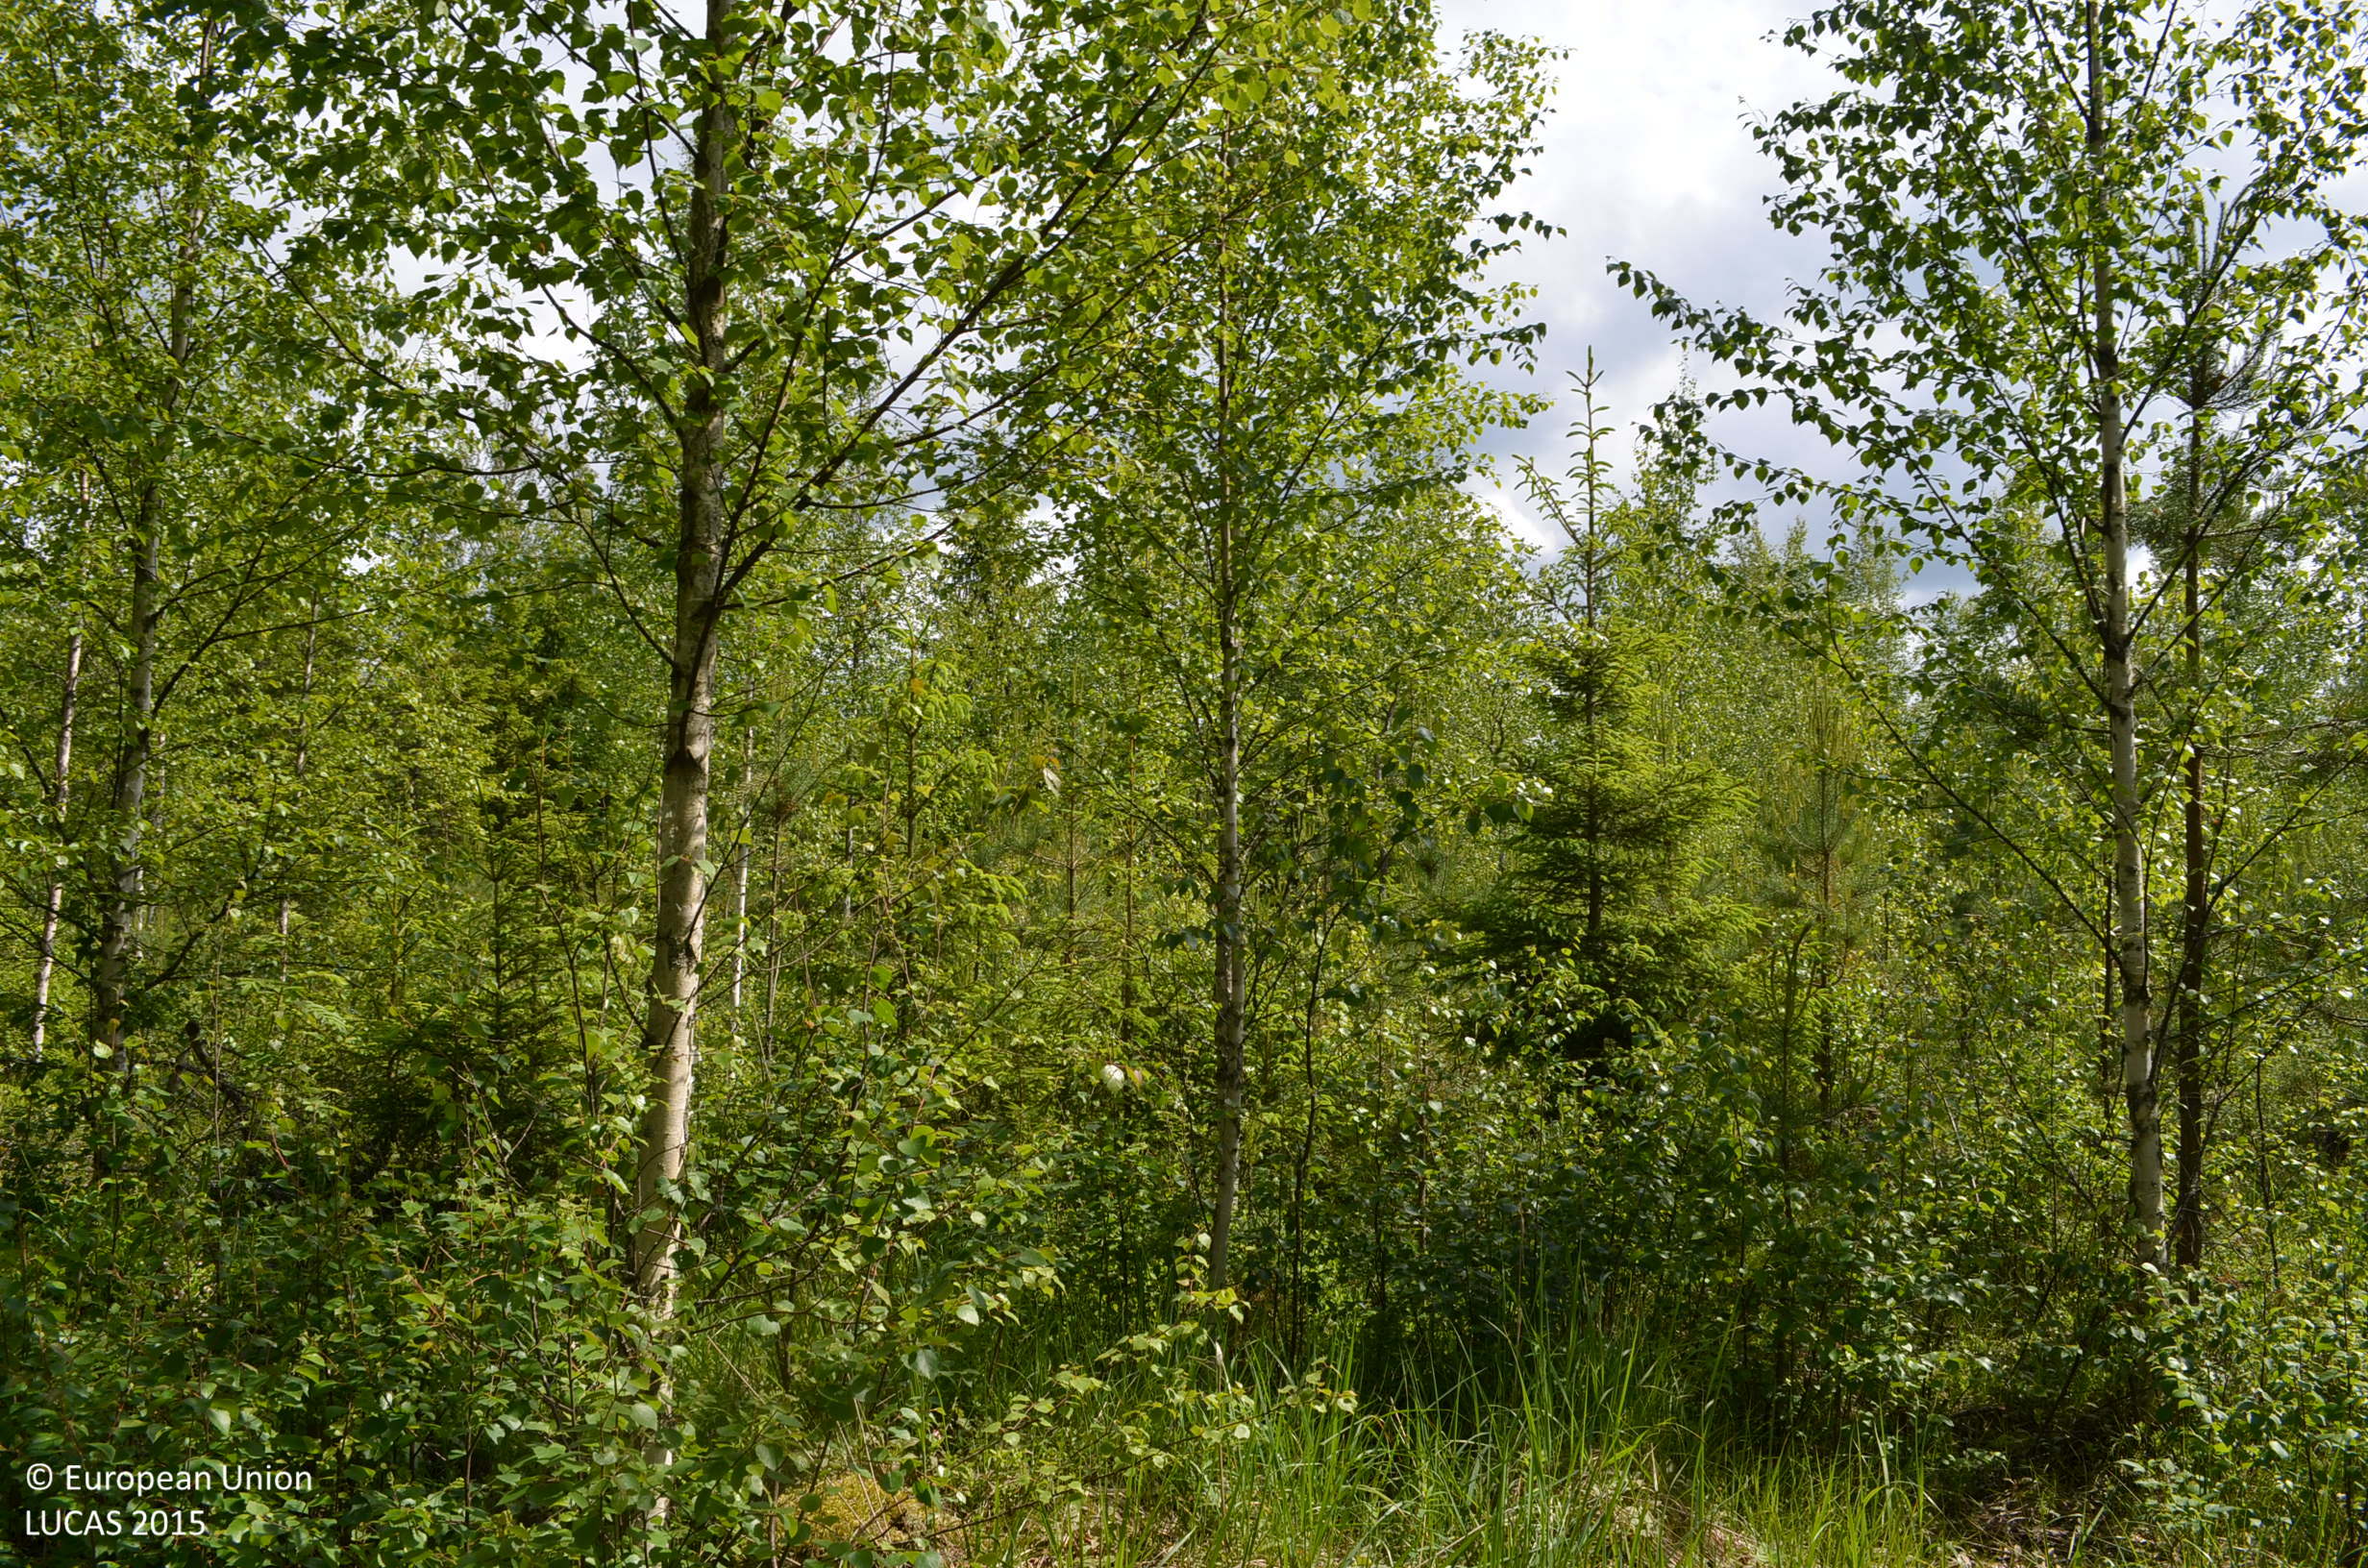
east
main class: Woodland
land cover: Other mixed woodland
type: boreal forest
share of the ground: > 75 %
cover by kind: broadleaved forest trees 40 %, coniferous forest trees 35 %, shrubs 20 %, herbaceous plants 5 %
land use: Forestry
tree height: < 5 m
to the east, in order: Other mixed woodland; Ditches and canals; Other mixed woodland; Ditches and canals; Other mixed woodland; Ditches and canals; Pine dominated mixed woodland; Ditches and canals; Pine dominated mixed woodland; Ditches and canals; Pine dominated mixed woodland; Ditches and canals; Pine dominated mixed woodland; Ditches and canals; Pine dominated mixed woodland
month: June
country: FI
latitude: 61.6584
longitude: 23.2349
